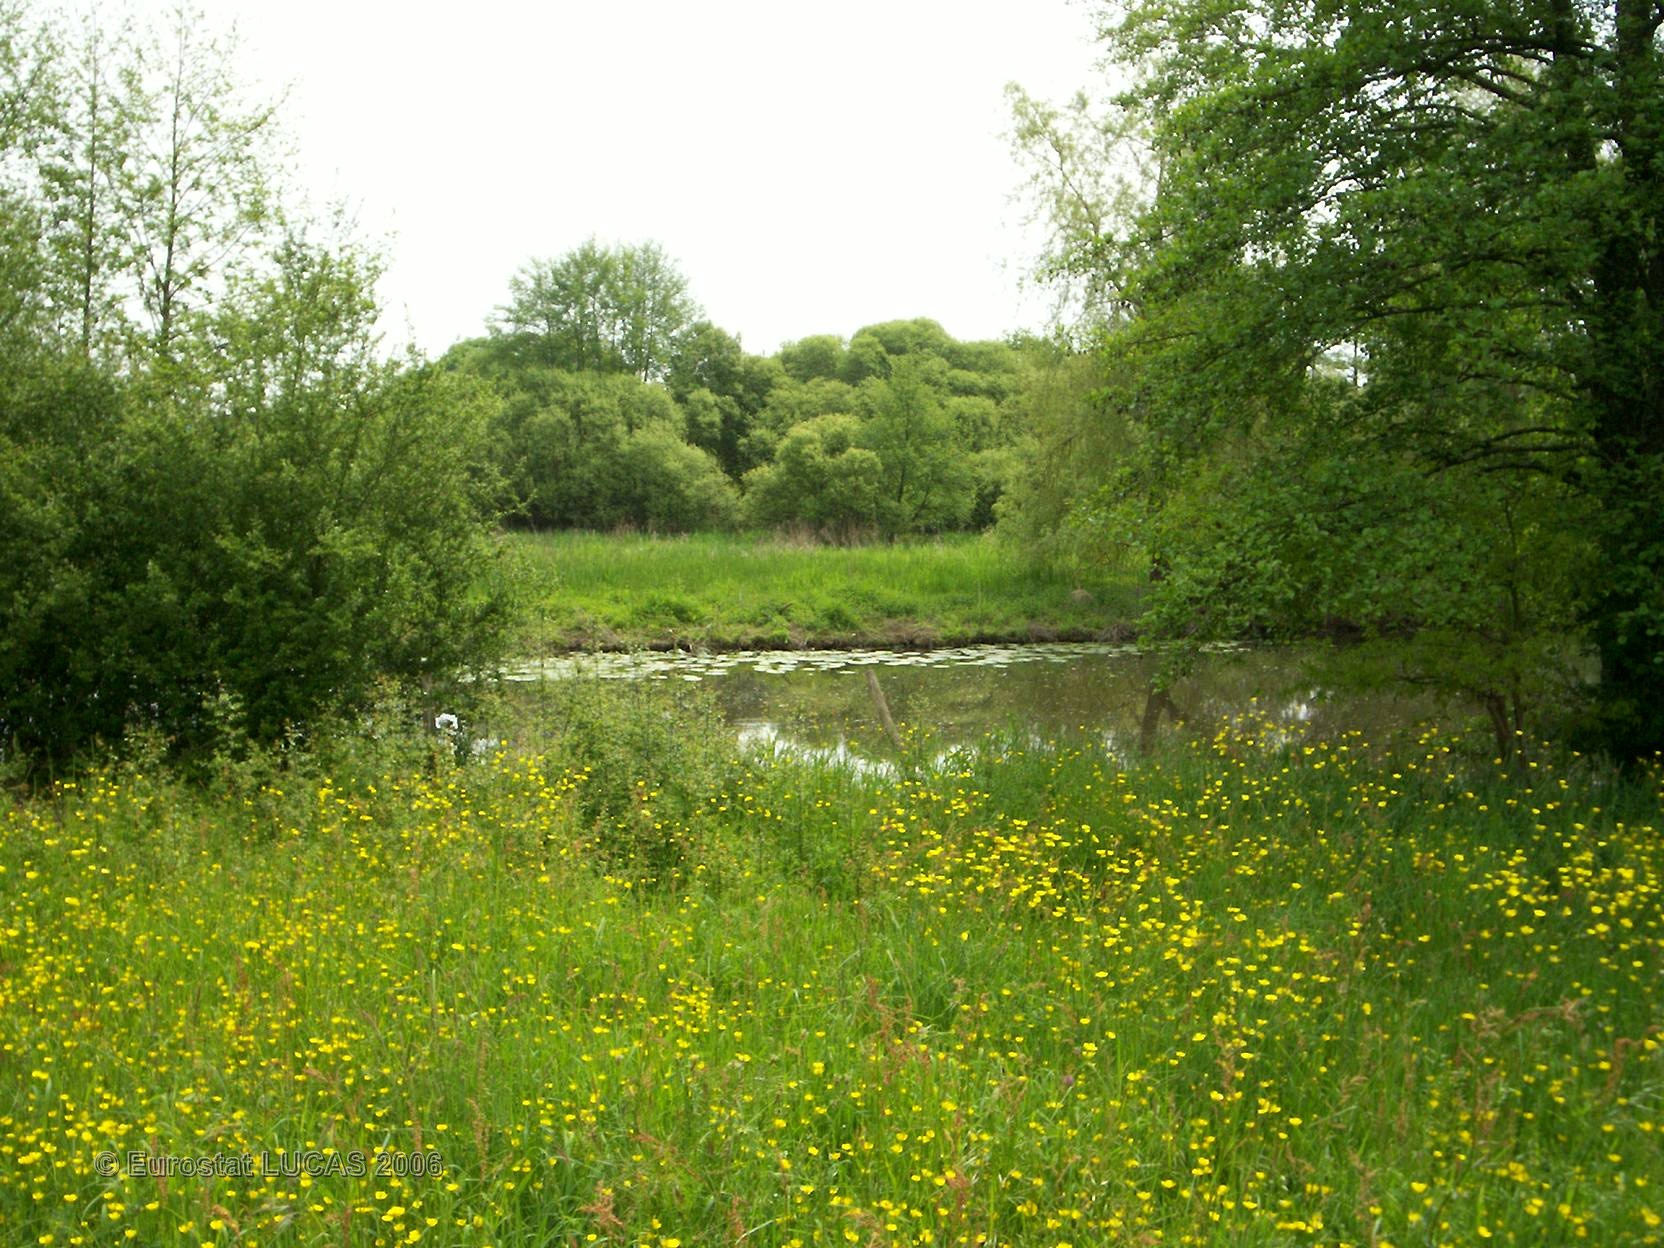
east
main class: Grassland
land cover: Grassland without tree/shrub cover
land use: Agriculture (excluding fallow land and kitchen gardens)
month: May
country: FR
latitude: 47.7083
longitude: -1.5193
